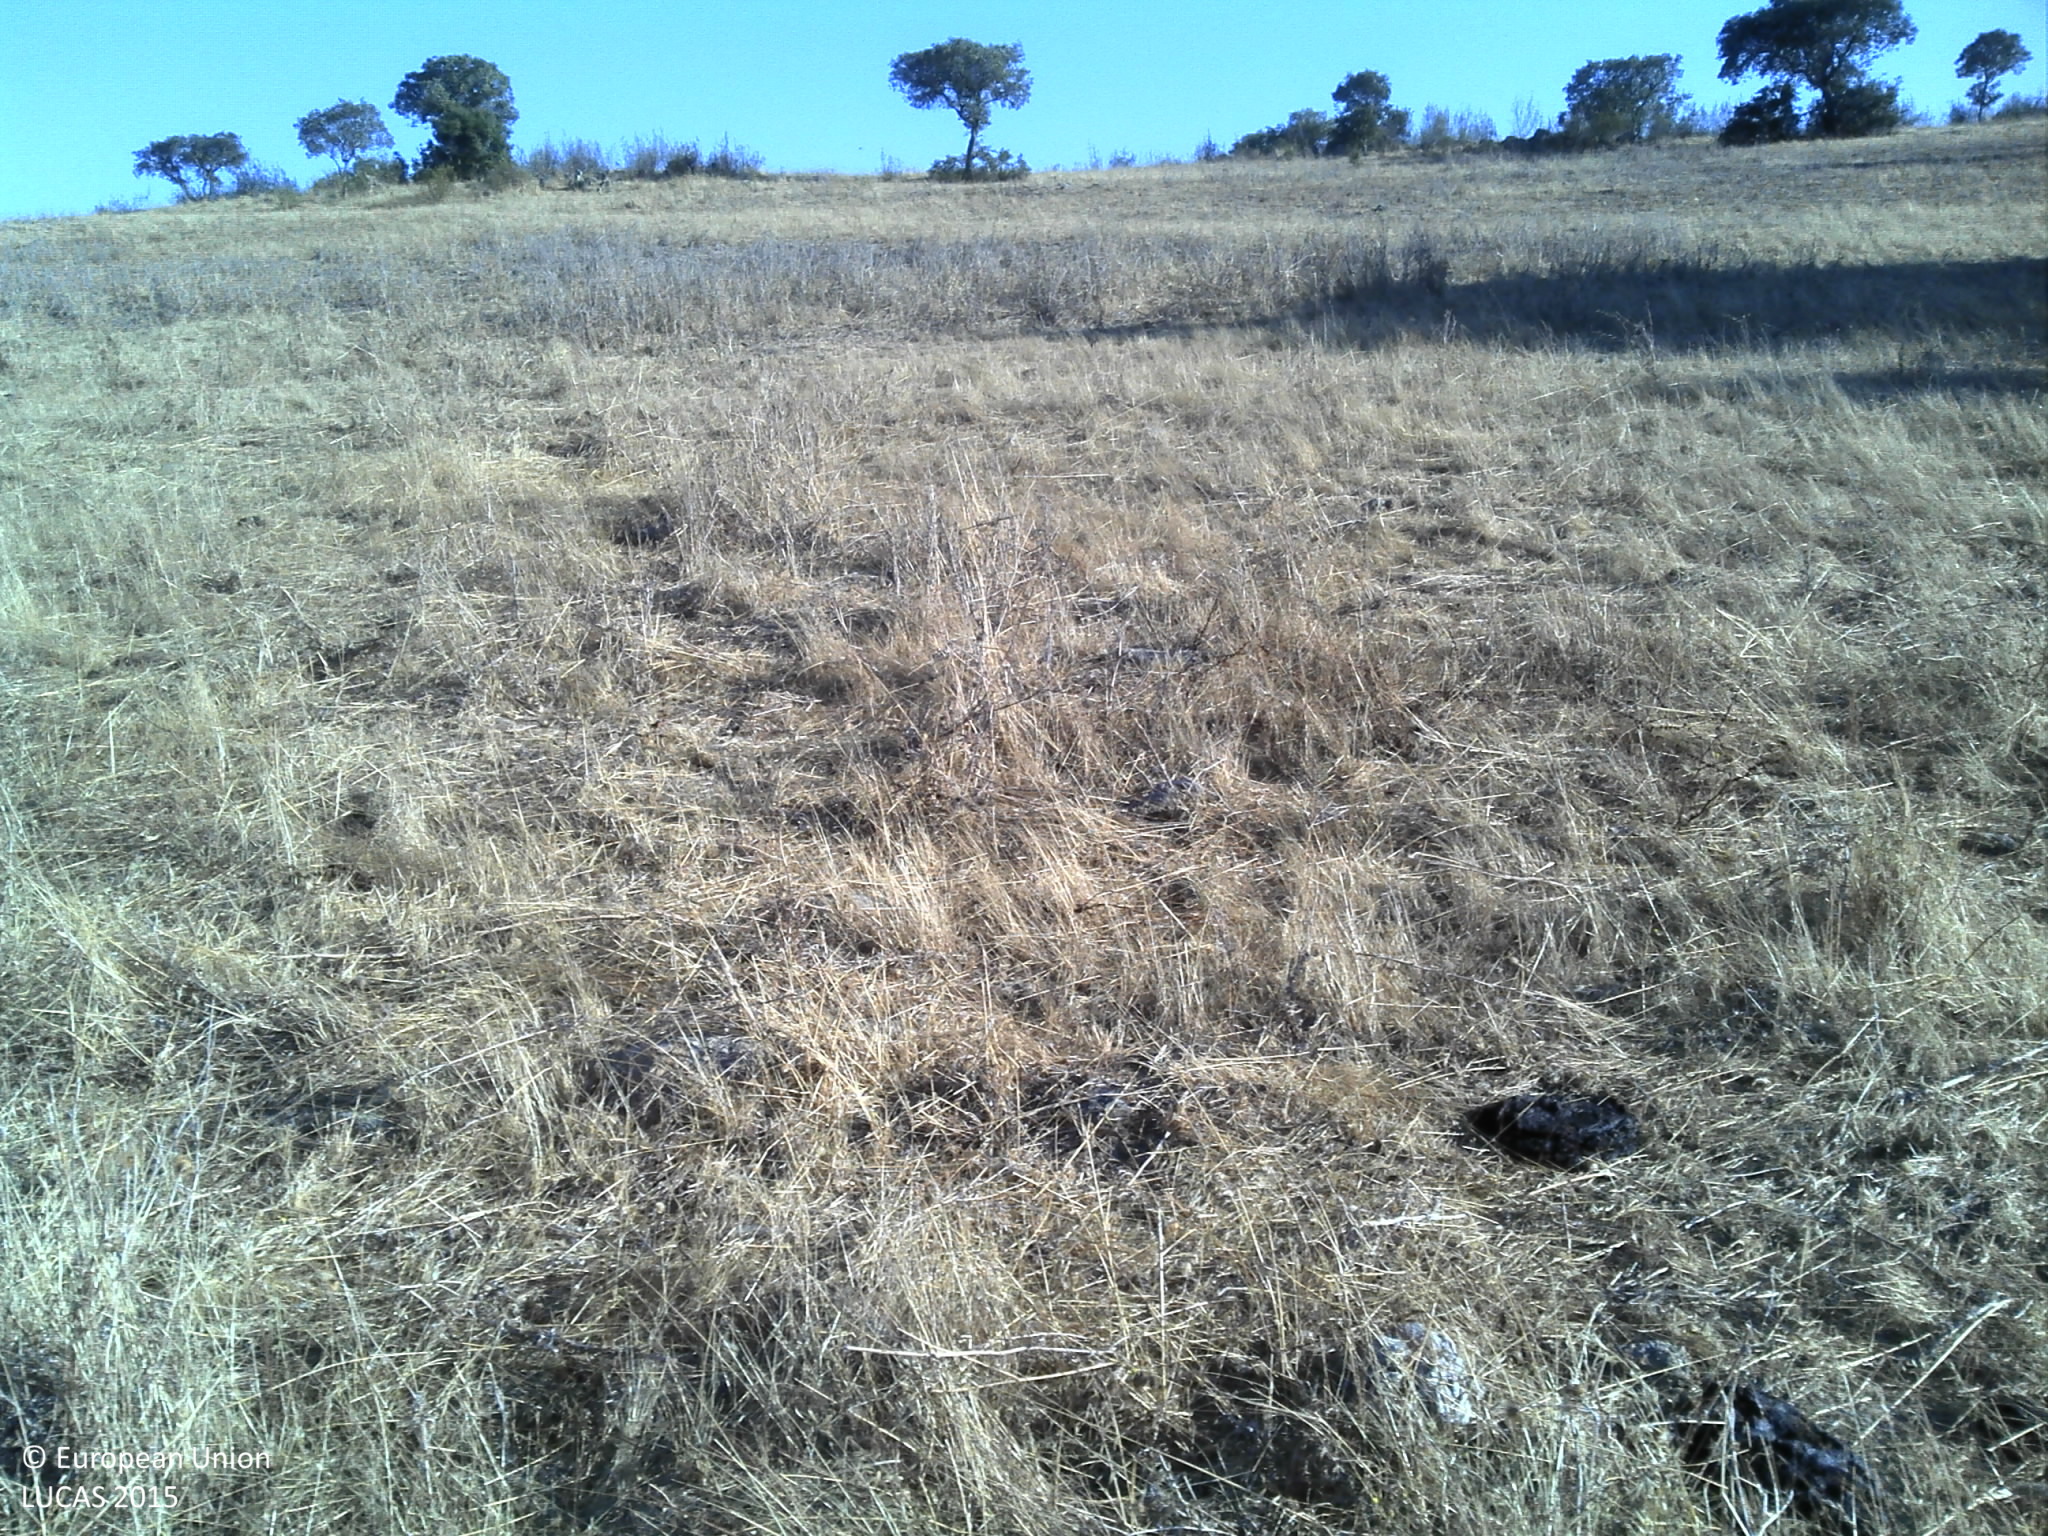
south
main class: Grassland
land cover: Grassland with sparse tree/shrub cover
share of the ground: > 75 %
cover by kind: herbaceous plants 90 %, broadleaved forest trees 5 %, unconsolidated bare surface 5 %
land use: Agriculture (excluding fallow land and kitchen gardens)
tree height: < 5 m
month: July
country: PT
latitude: 37.7208
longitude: -7.9838
